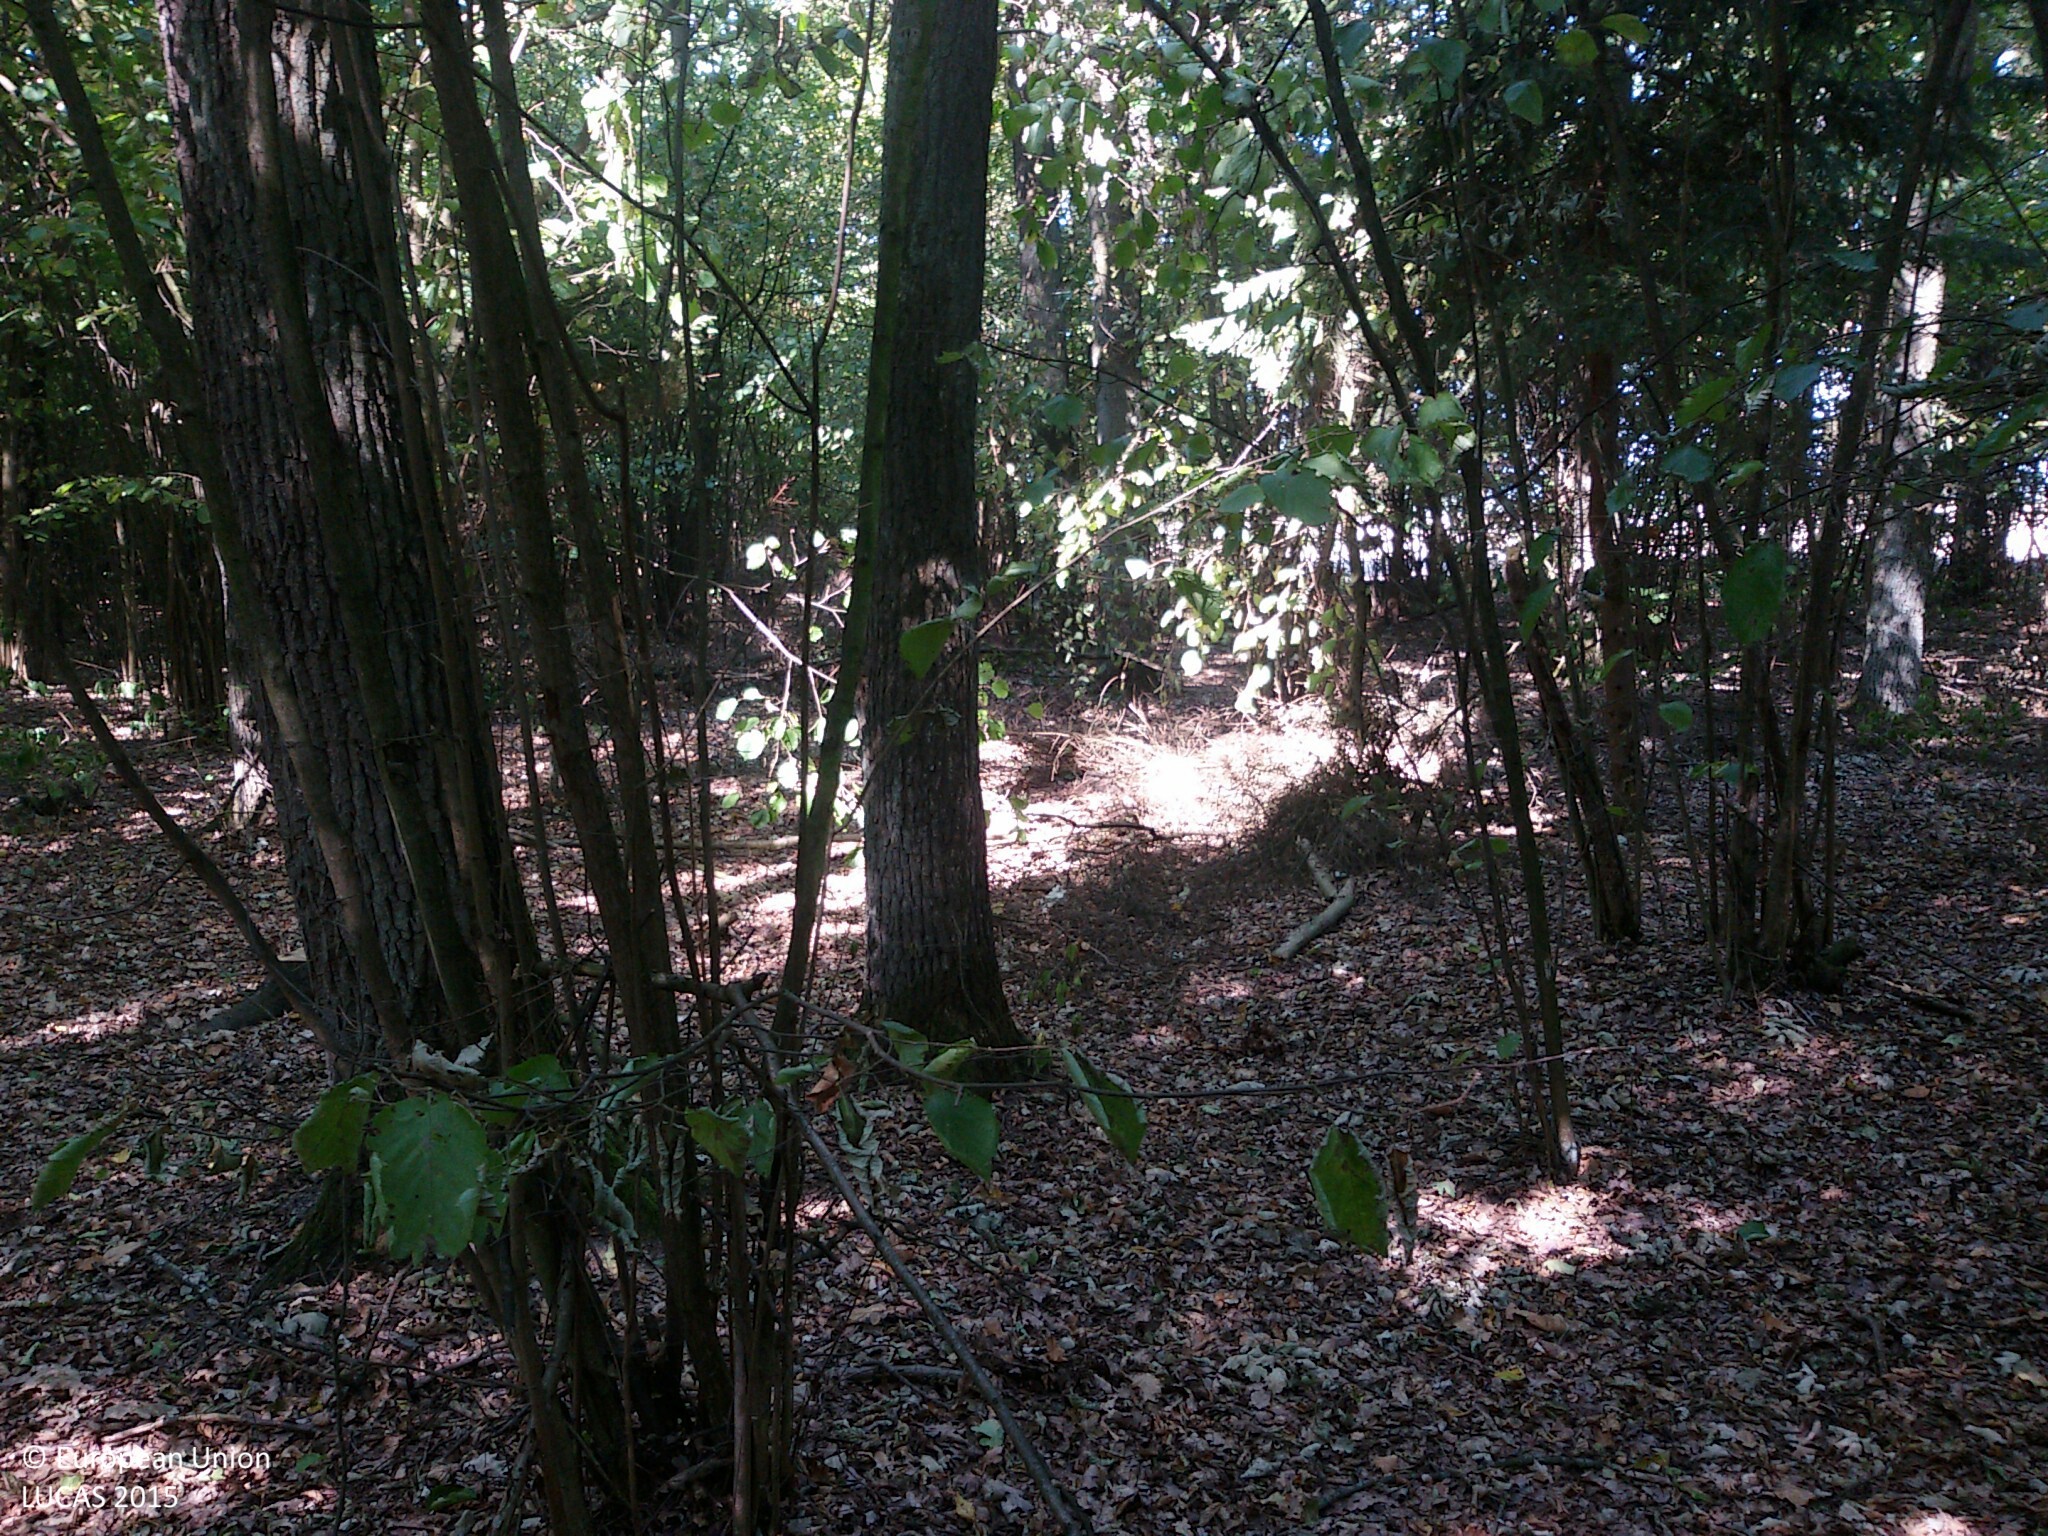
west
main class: Woodland
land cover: Pine dominated mixed woodland
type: hemiboreal forest and nemoral coniferous forest and mixed broadleaved-coniferous forest
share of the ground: > 75 %
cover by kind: coniferous forest trees 45 %, broadleaved forest trees 45 %, shrubs 5 %, herbaceous plants 5 %
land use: Forestry
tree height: > 5 m
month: August
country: PL
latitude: 52.7750
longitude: 20.9686
